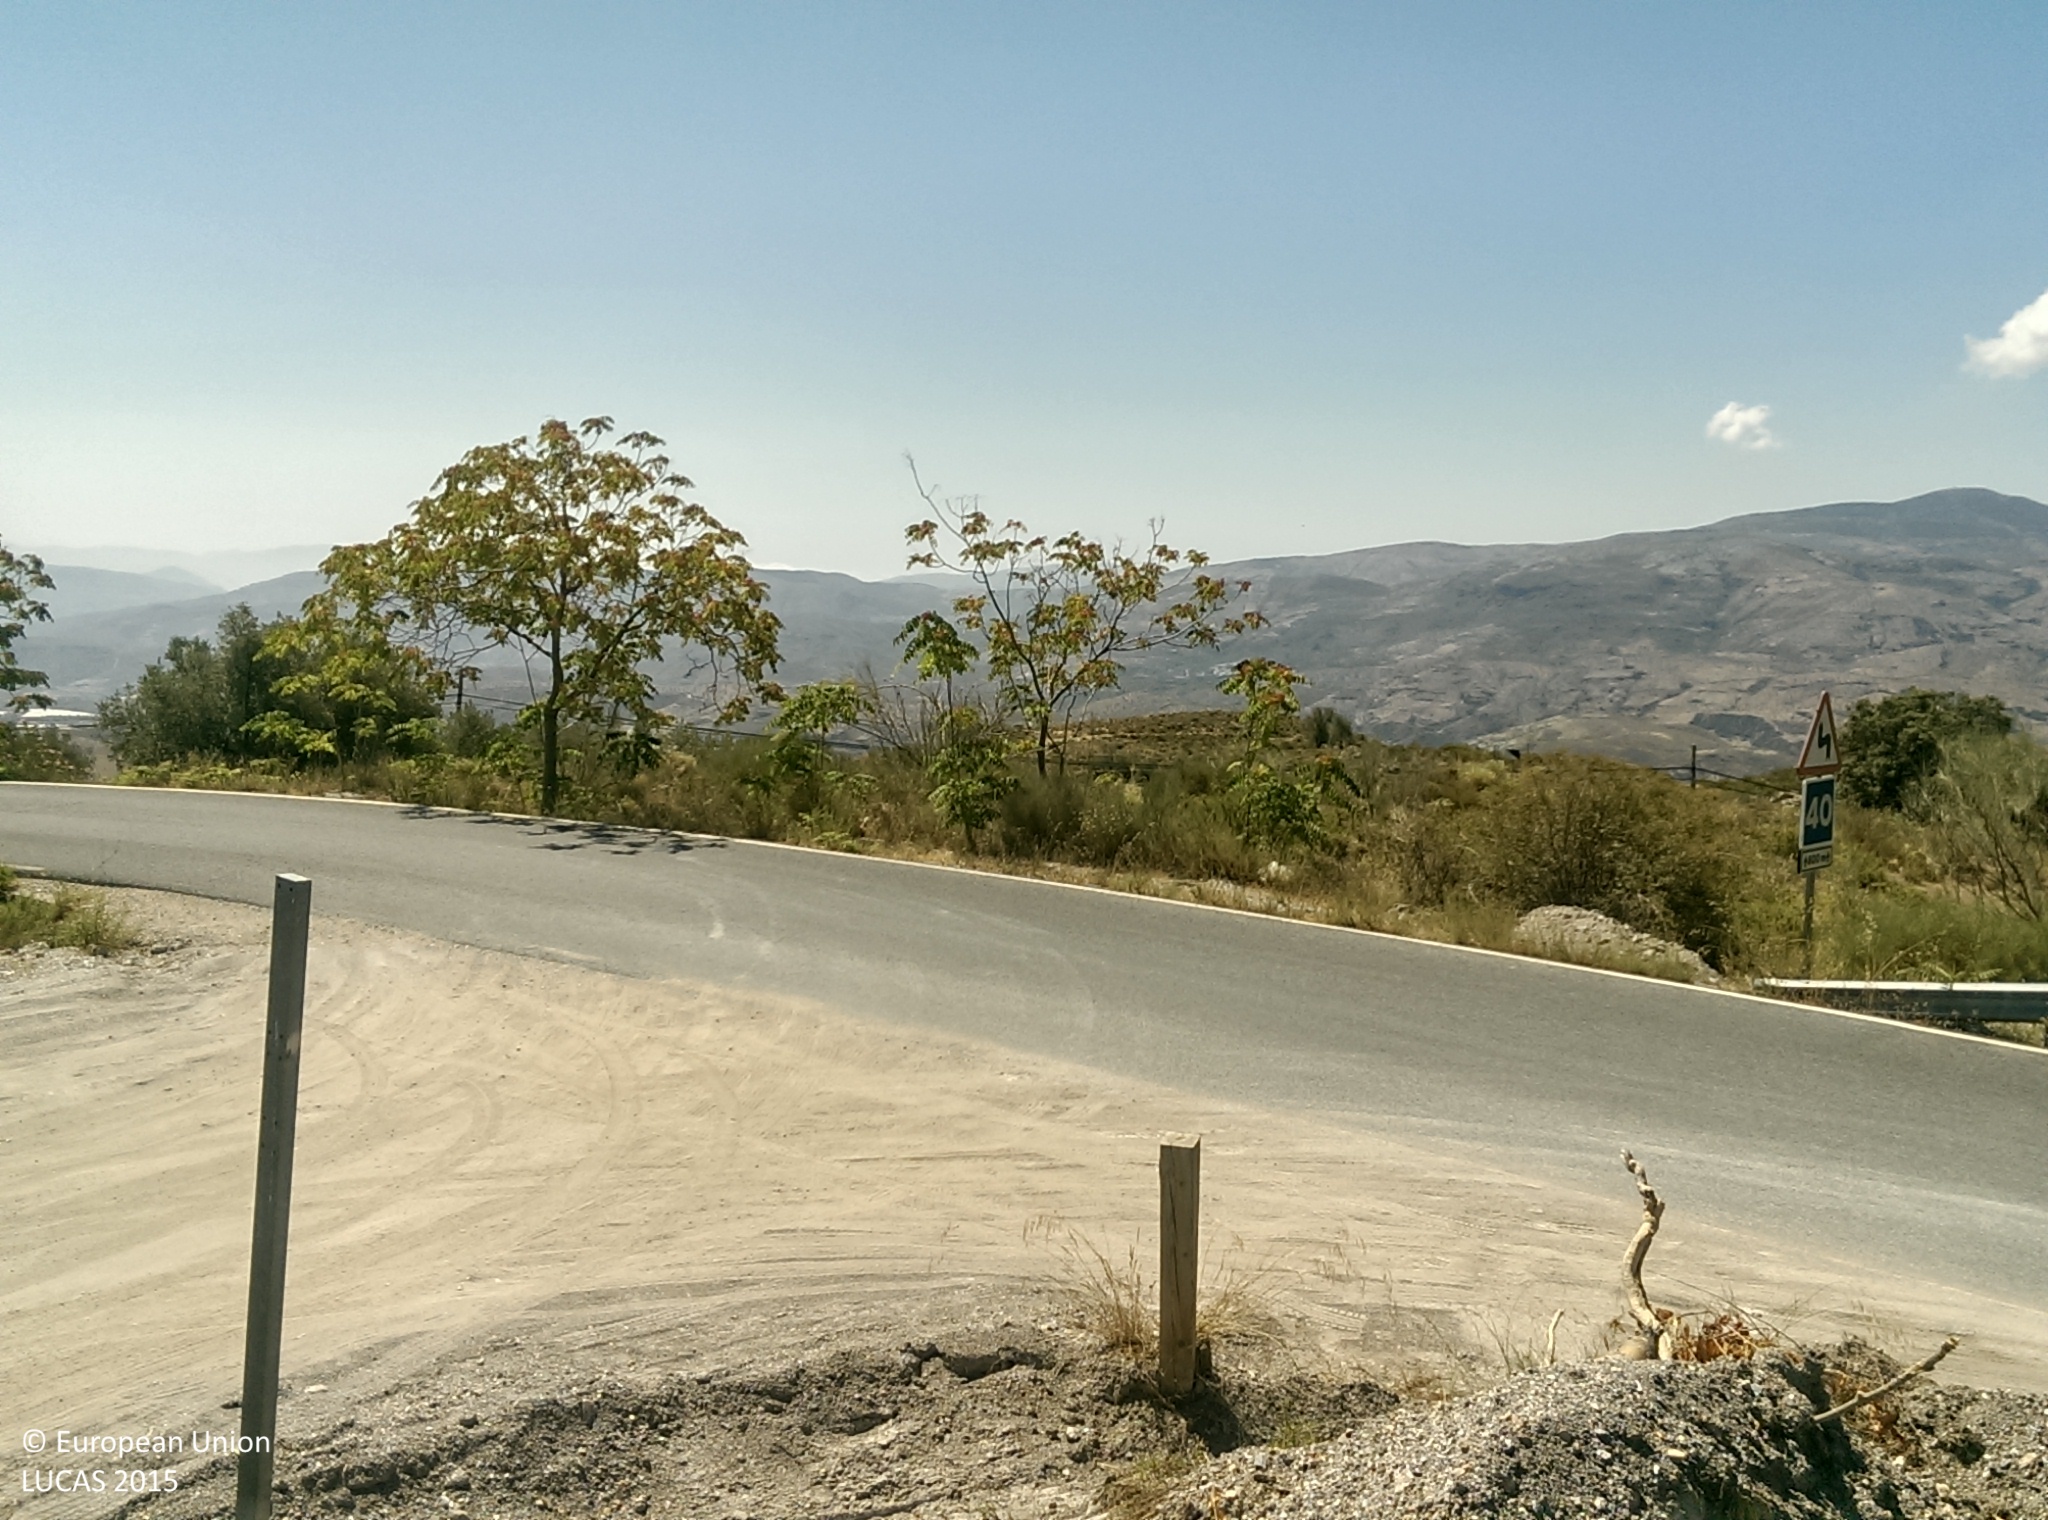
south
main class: Shrubland
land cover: Shrubland without tree cover
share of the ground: > 75 %
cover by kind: shrubs 75 %, herbaceous plants 20 %, unconsolidated bare surface 5 %
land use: Semi-natural and natural areas not in use
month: July
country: ES
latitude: 36.9787
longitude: -3.1369
